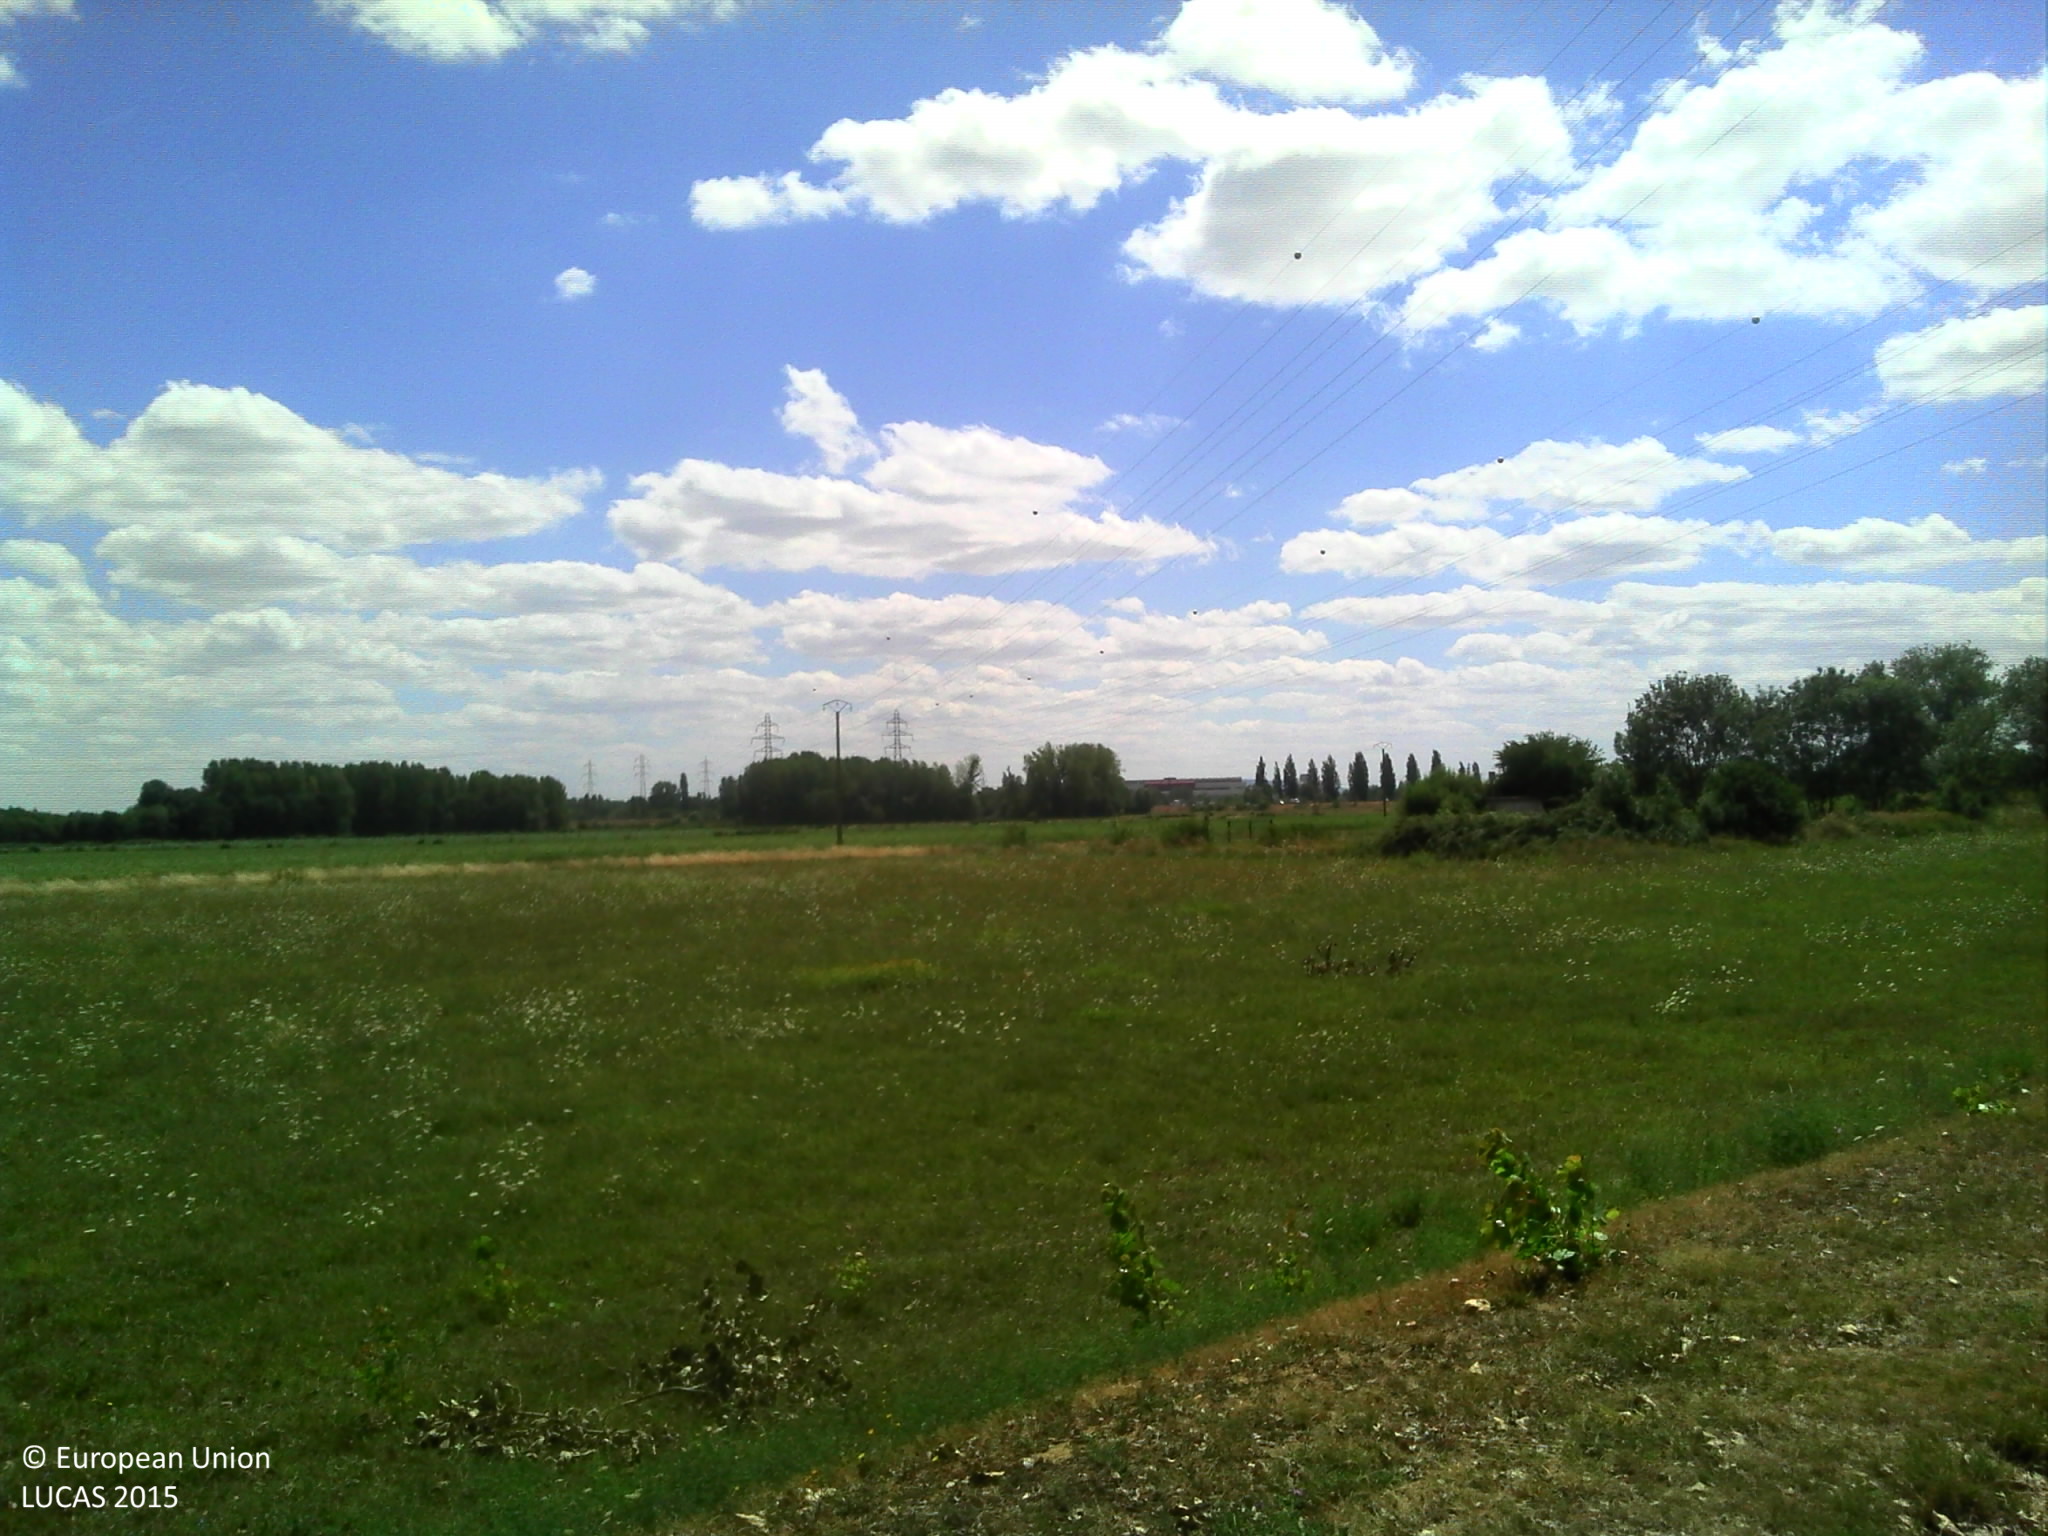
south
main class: Woodland
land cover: Broadleaved woodland
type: floodplain forest
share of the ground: > 75 %
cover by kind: broadleaved forest trees 60 %, herbaceous plants 30 %
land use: Amenities, museums, leisure
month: July
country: FR
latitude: 46.7880
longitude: 4.8794
